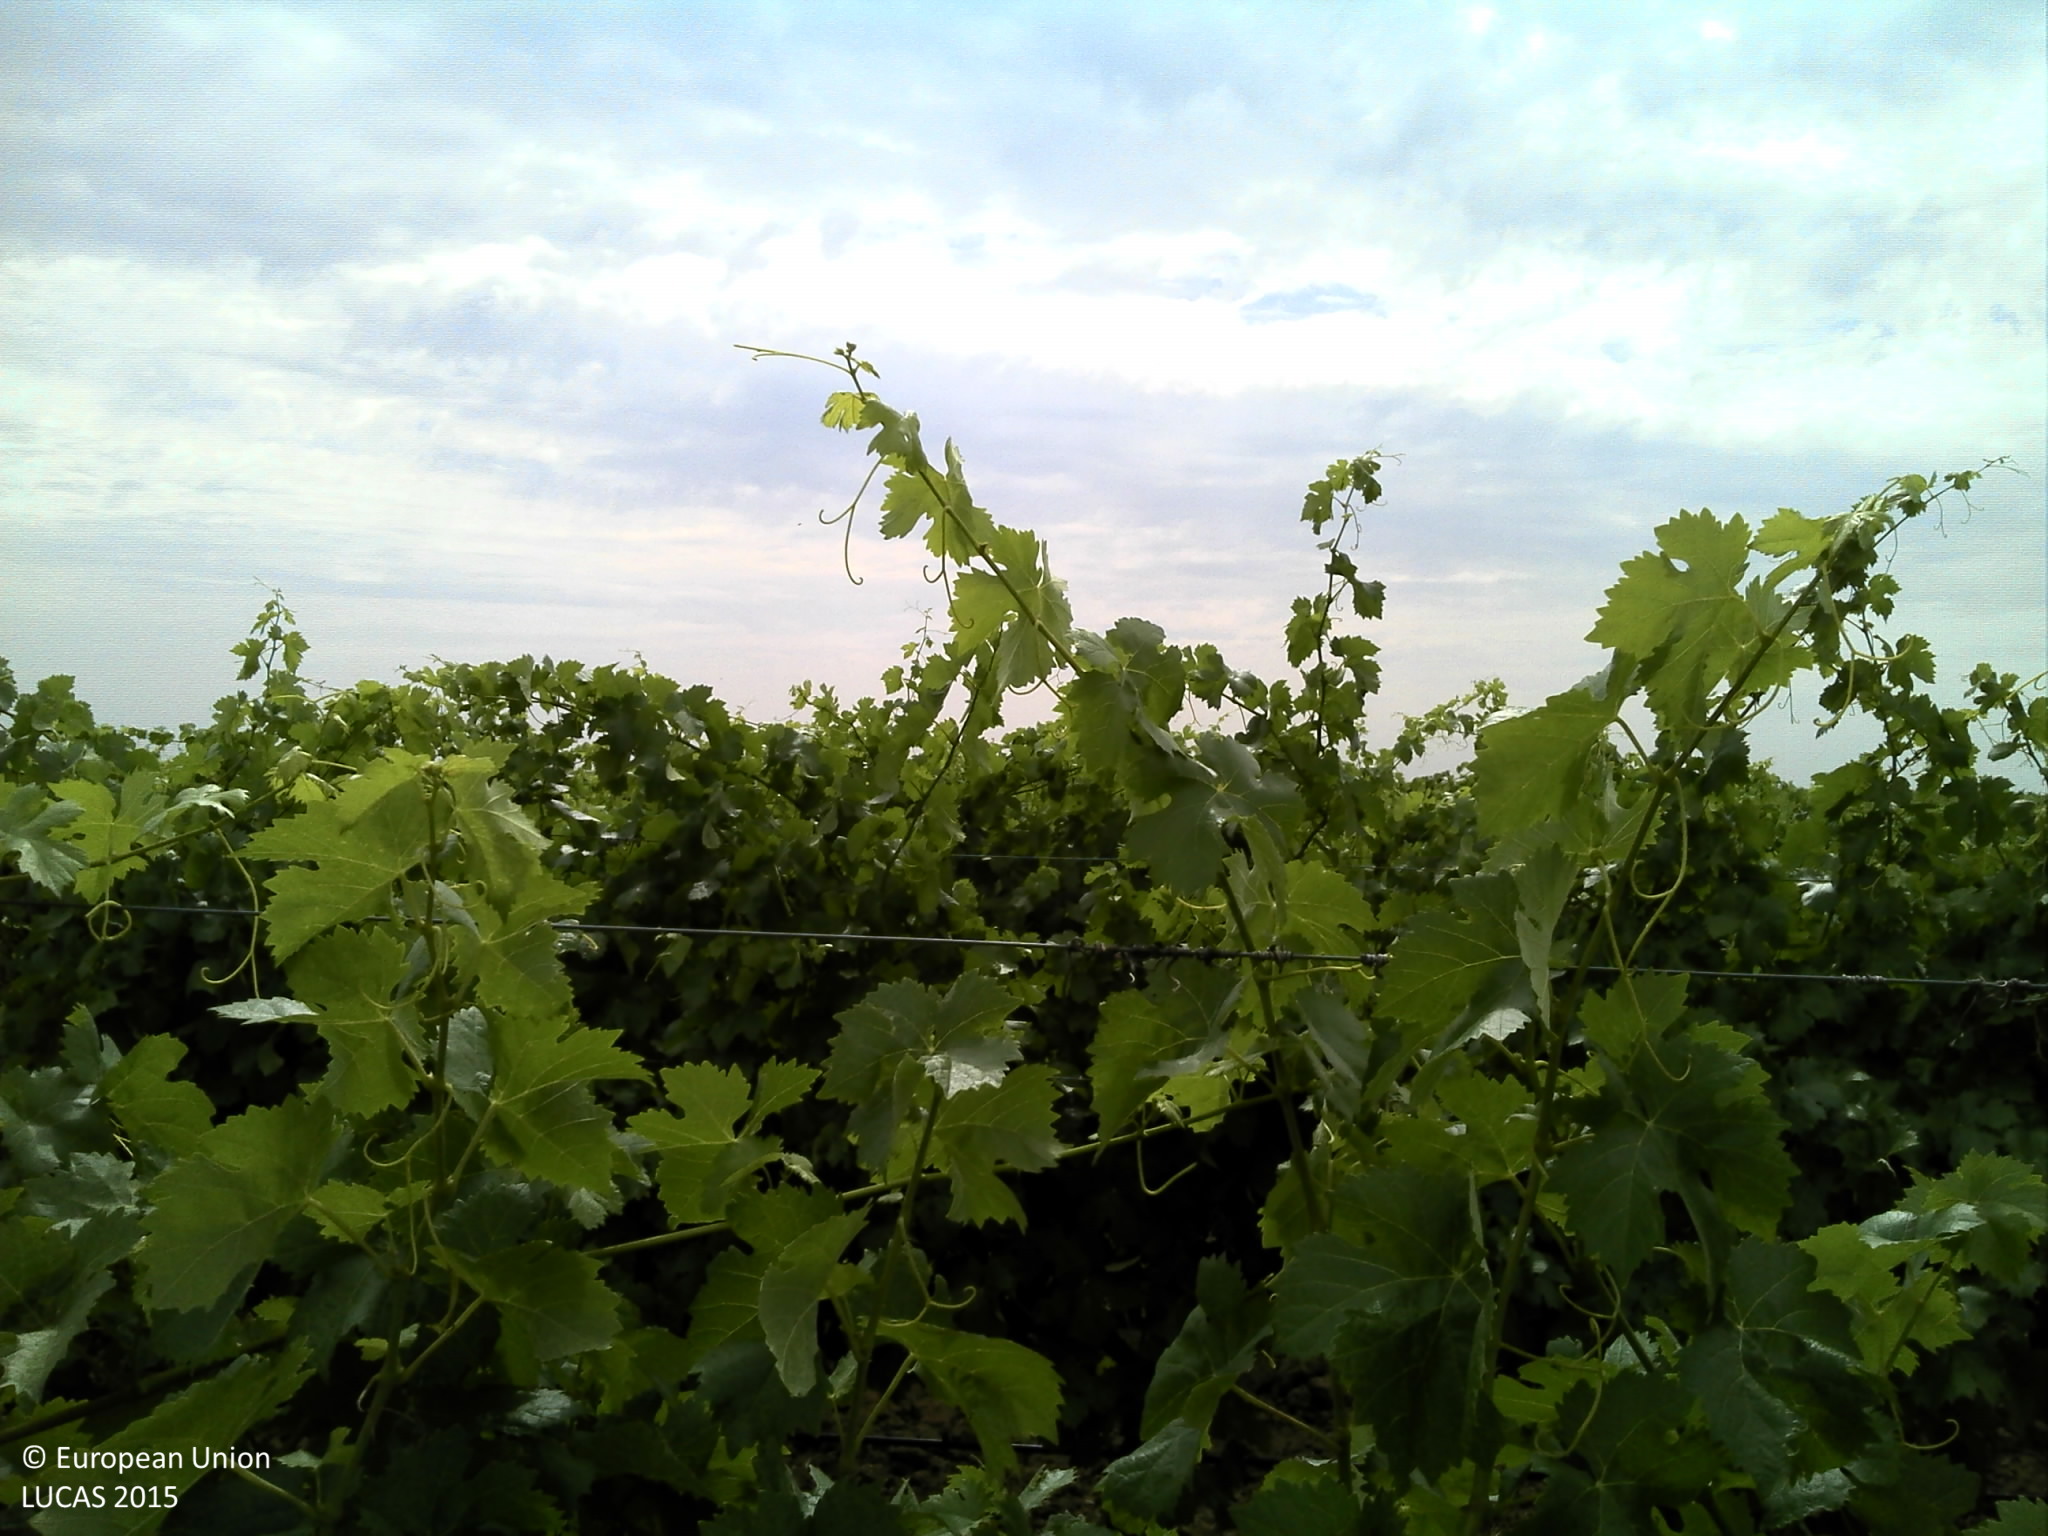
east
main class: Cropland
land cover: Vineyards
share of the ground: 25 - 50 %
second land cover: Other bare soil
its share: > 75 %
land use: Agriculture (excluding fallow land and kitchen gardens)
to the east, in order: Vineyards; Other bare soil; Vineyards
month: June
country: PT
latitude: 38.5447
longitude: -7.8325
